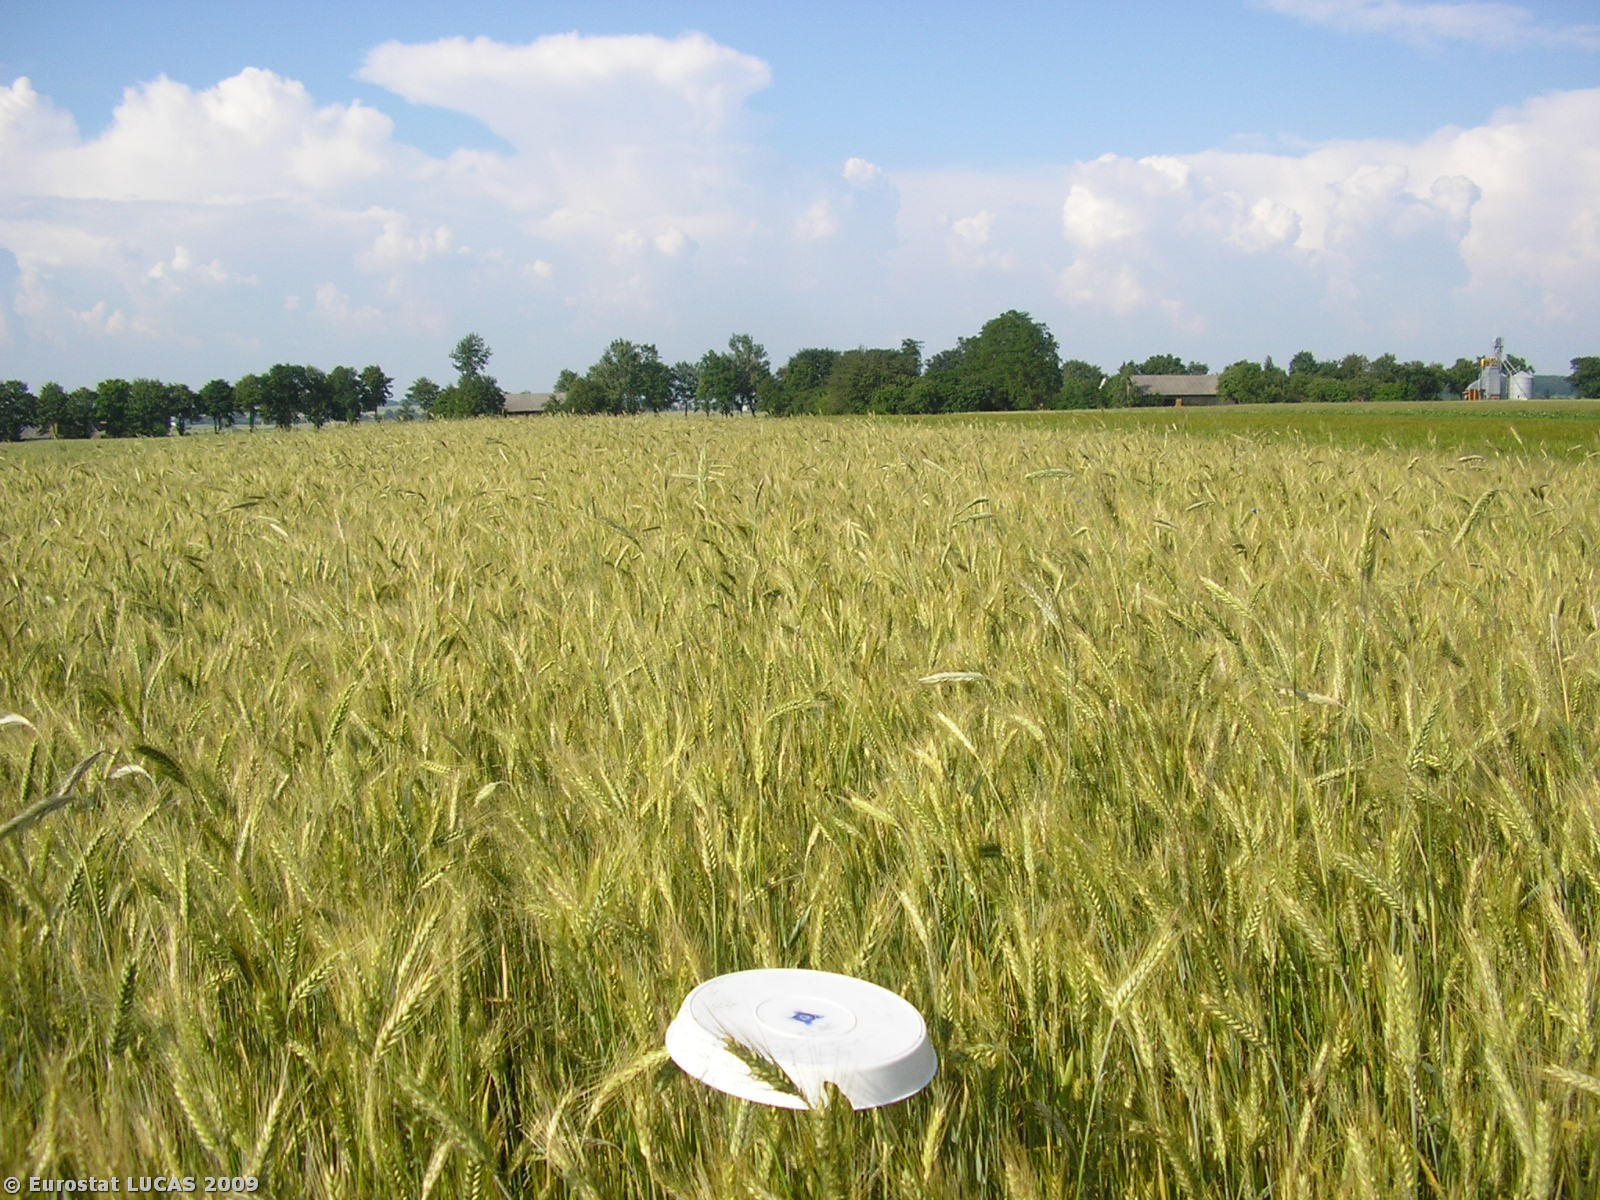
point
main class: Cropland
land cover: Triticale
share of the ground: > 75 %
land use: Agriculture (excluding fallow land and kitchen gardens)
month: June
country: PL
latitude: 50.4616
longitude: 20.0773
